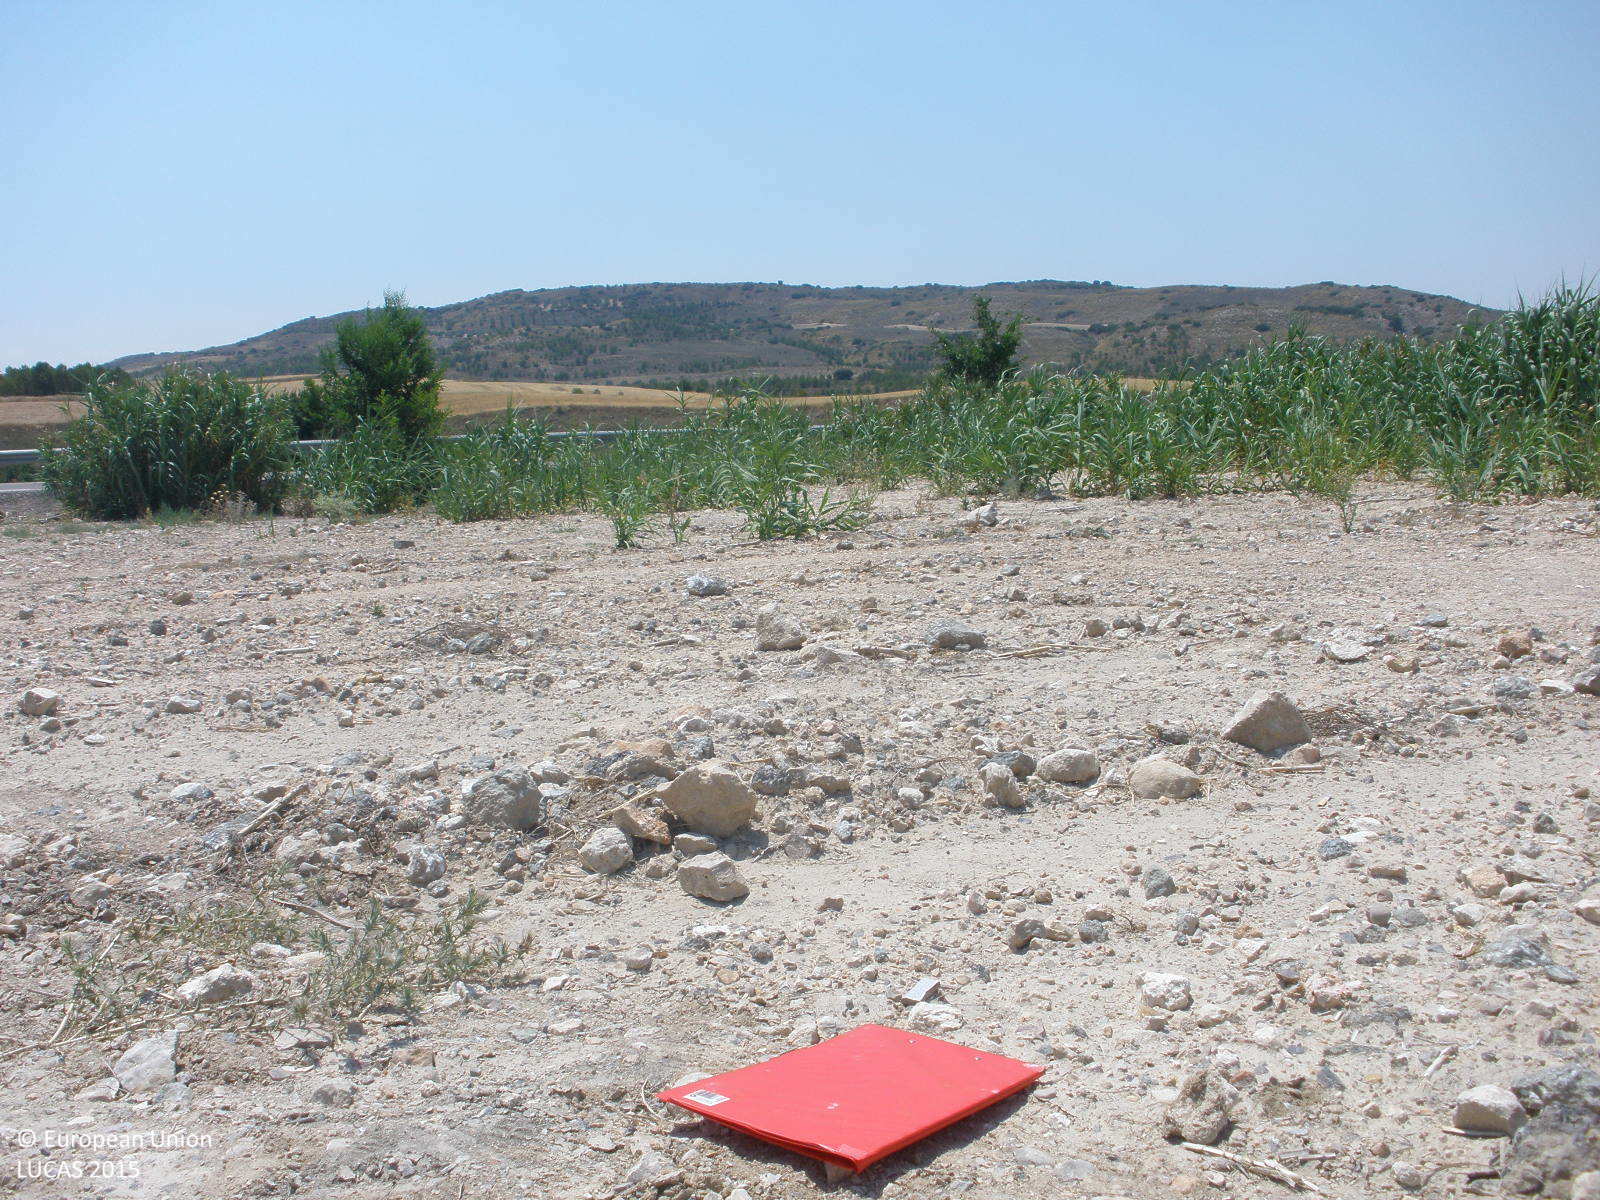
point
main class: Grassland
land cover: Spontaneously vegetated surfaces
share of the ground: 25 - 50 %
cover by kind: unconsolidated bare surface 75 %, herbaceous plants 25 %
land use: Semi-natural and natural areas not in use
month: June
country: ES
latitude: 40.2309
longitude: -3.2039
